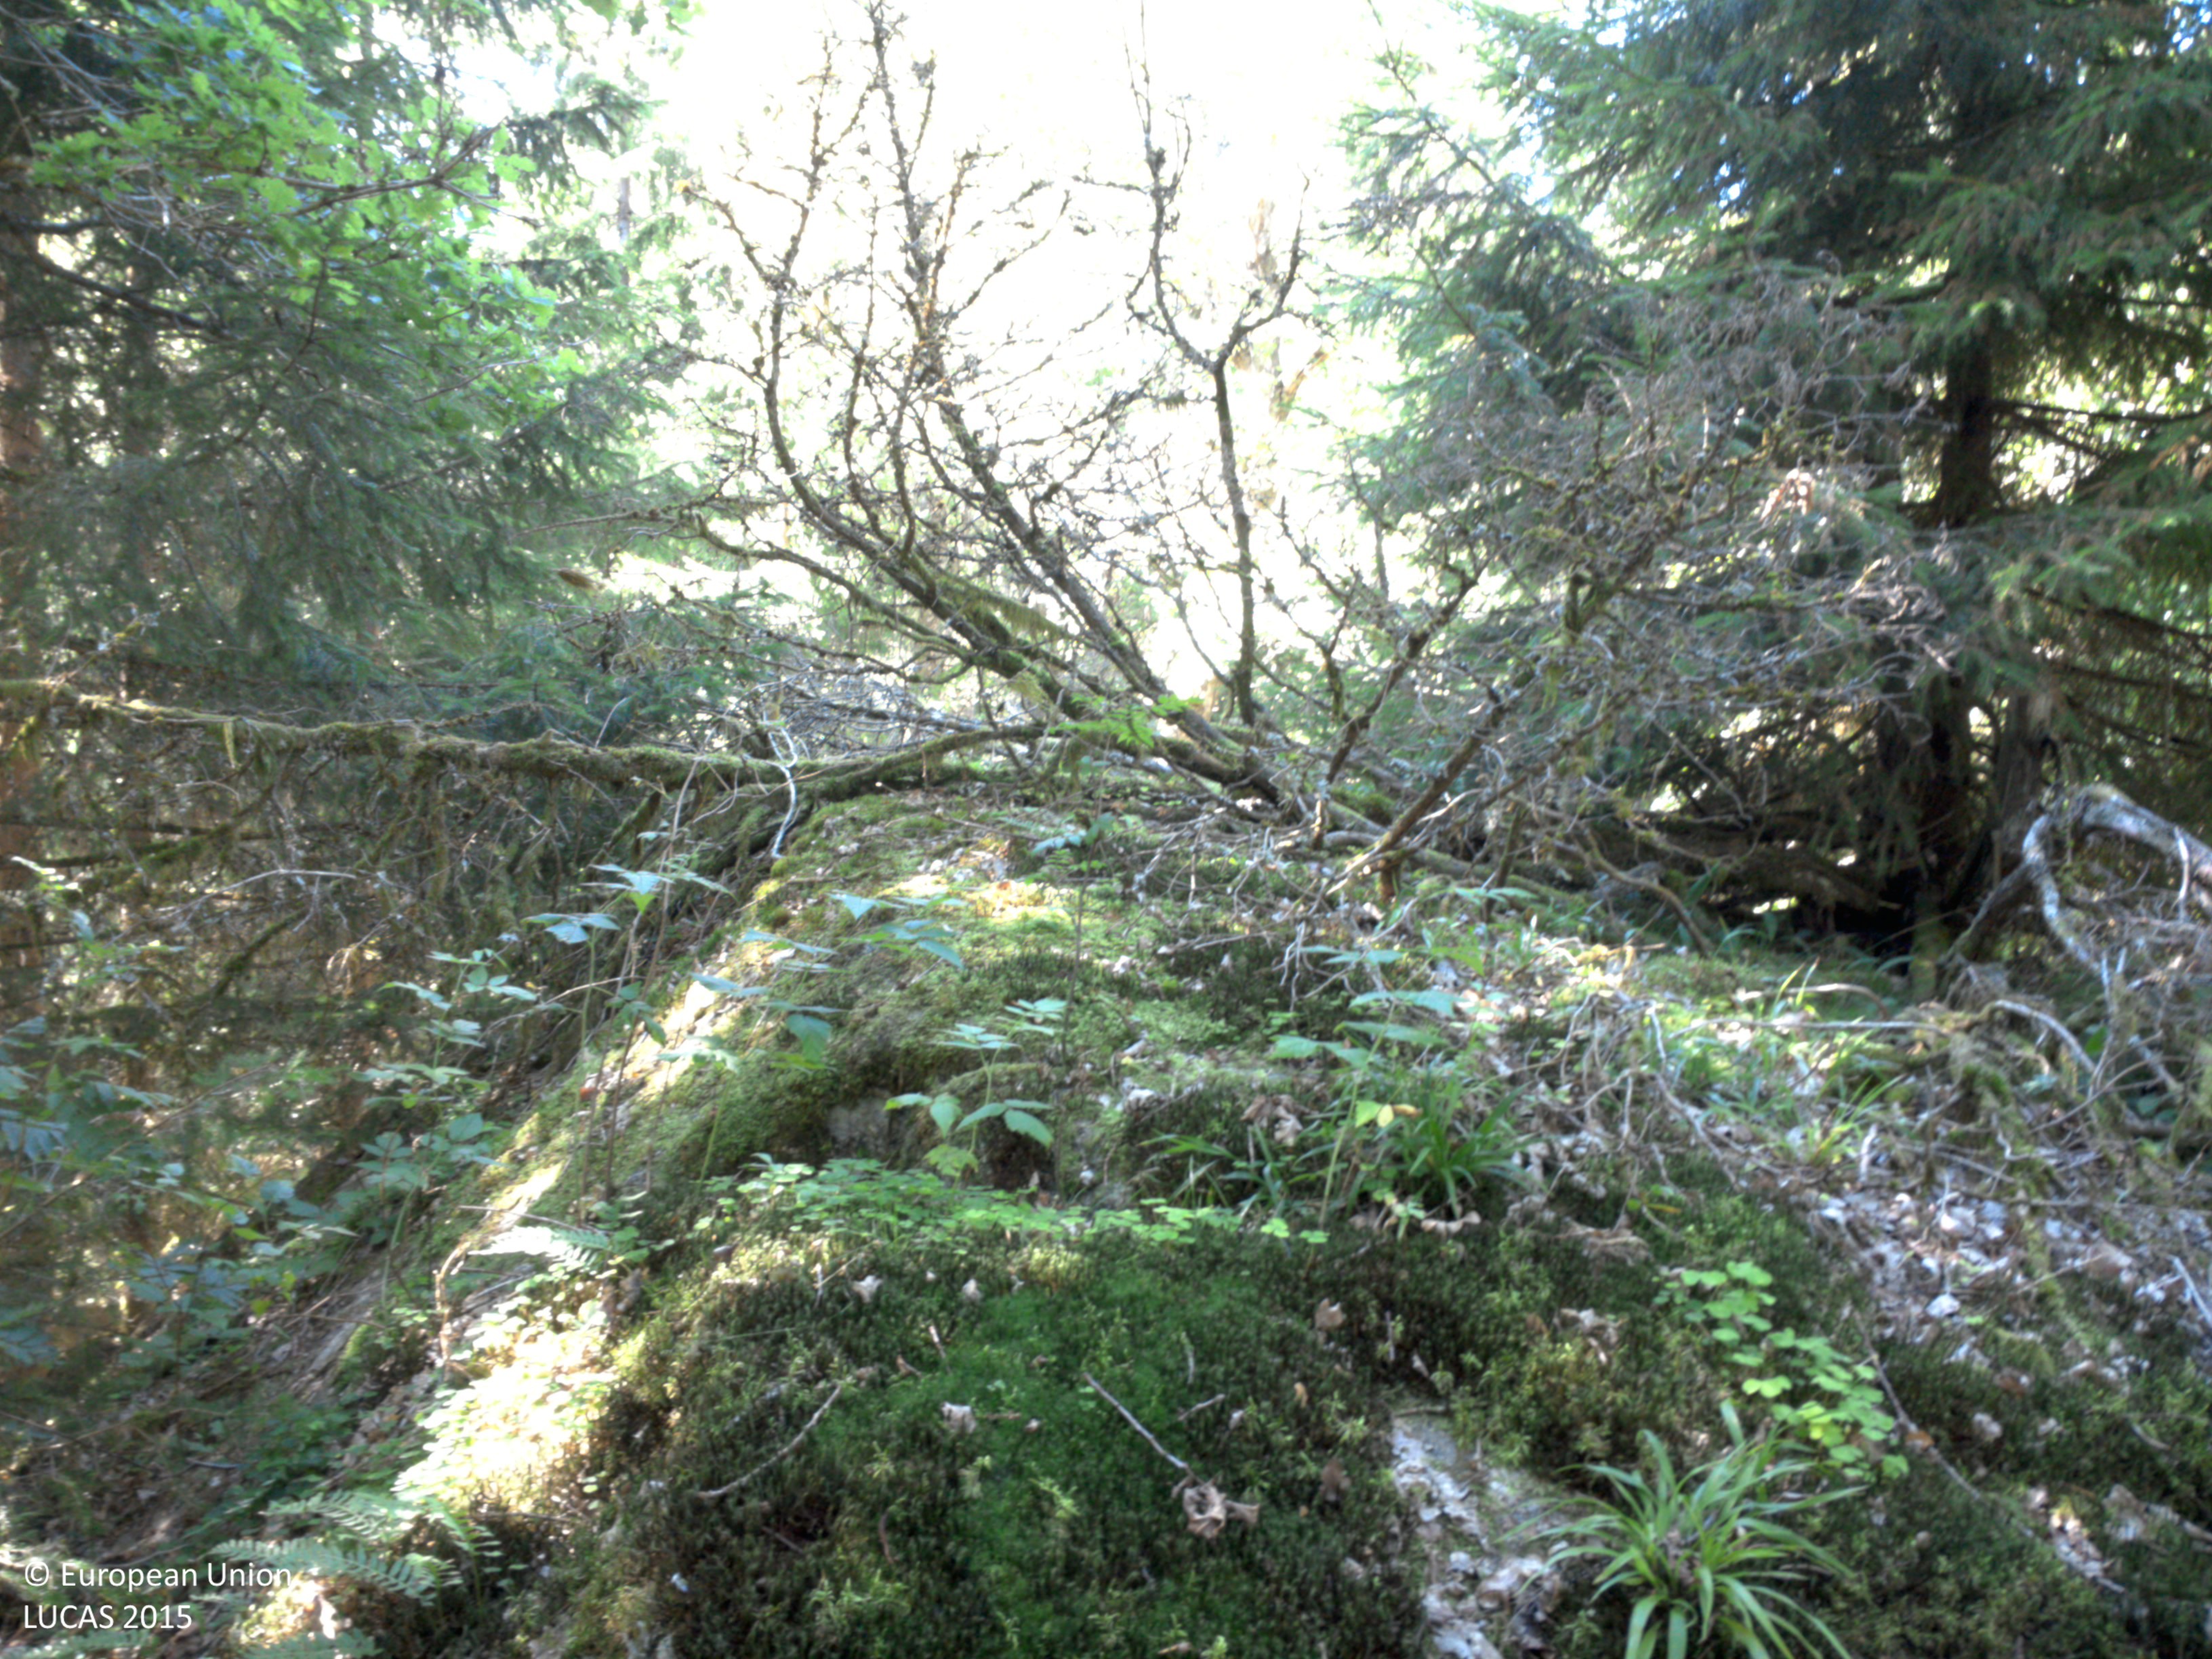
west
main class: Woodland
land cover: Spruce dominated mixed woodland
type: boreal forest
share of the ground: 50 - 75 %
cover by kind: coniferous forest trees 35 %, broadleaved forest trees 30 %, lichens and mosses 20 %, herbaceous plants 10 %, shrubs 5 %
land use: Forestry
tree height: > 5 m
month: August
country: SE
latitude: 58.2000
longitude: 12.2926
